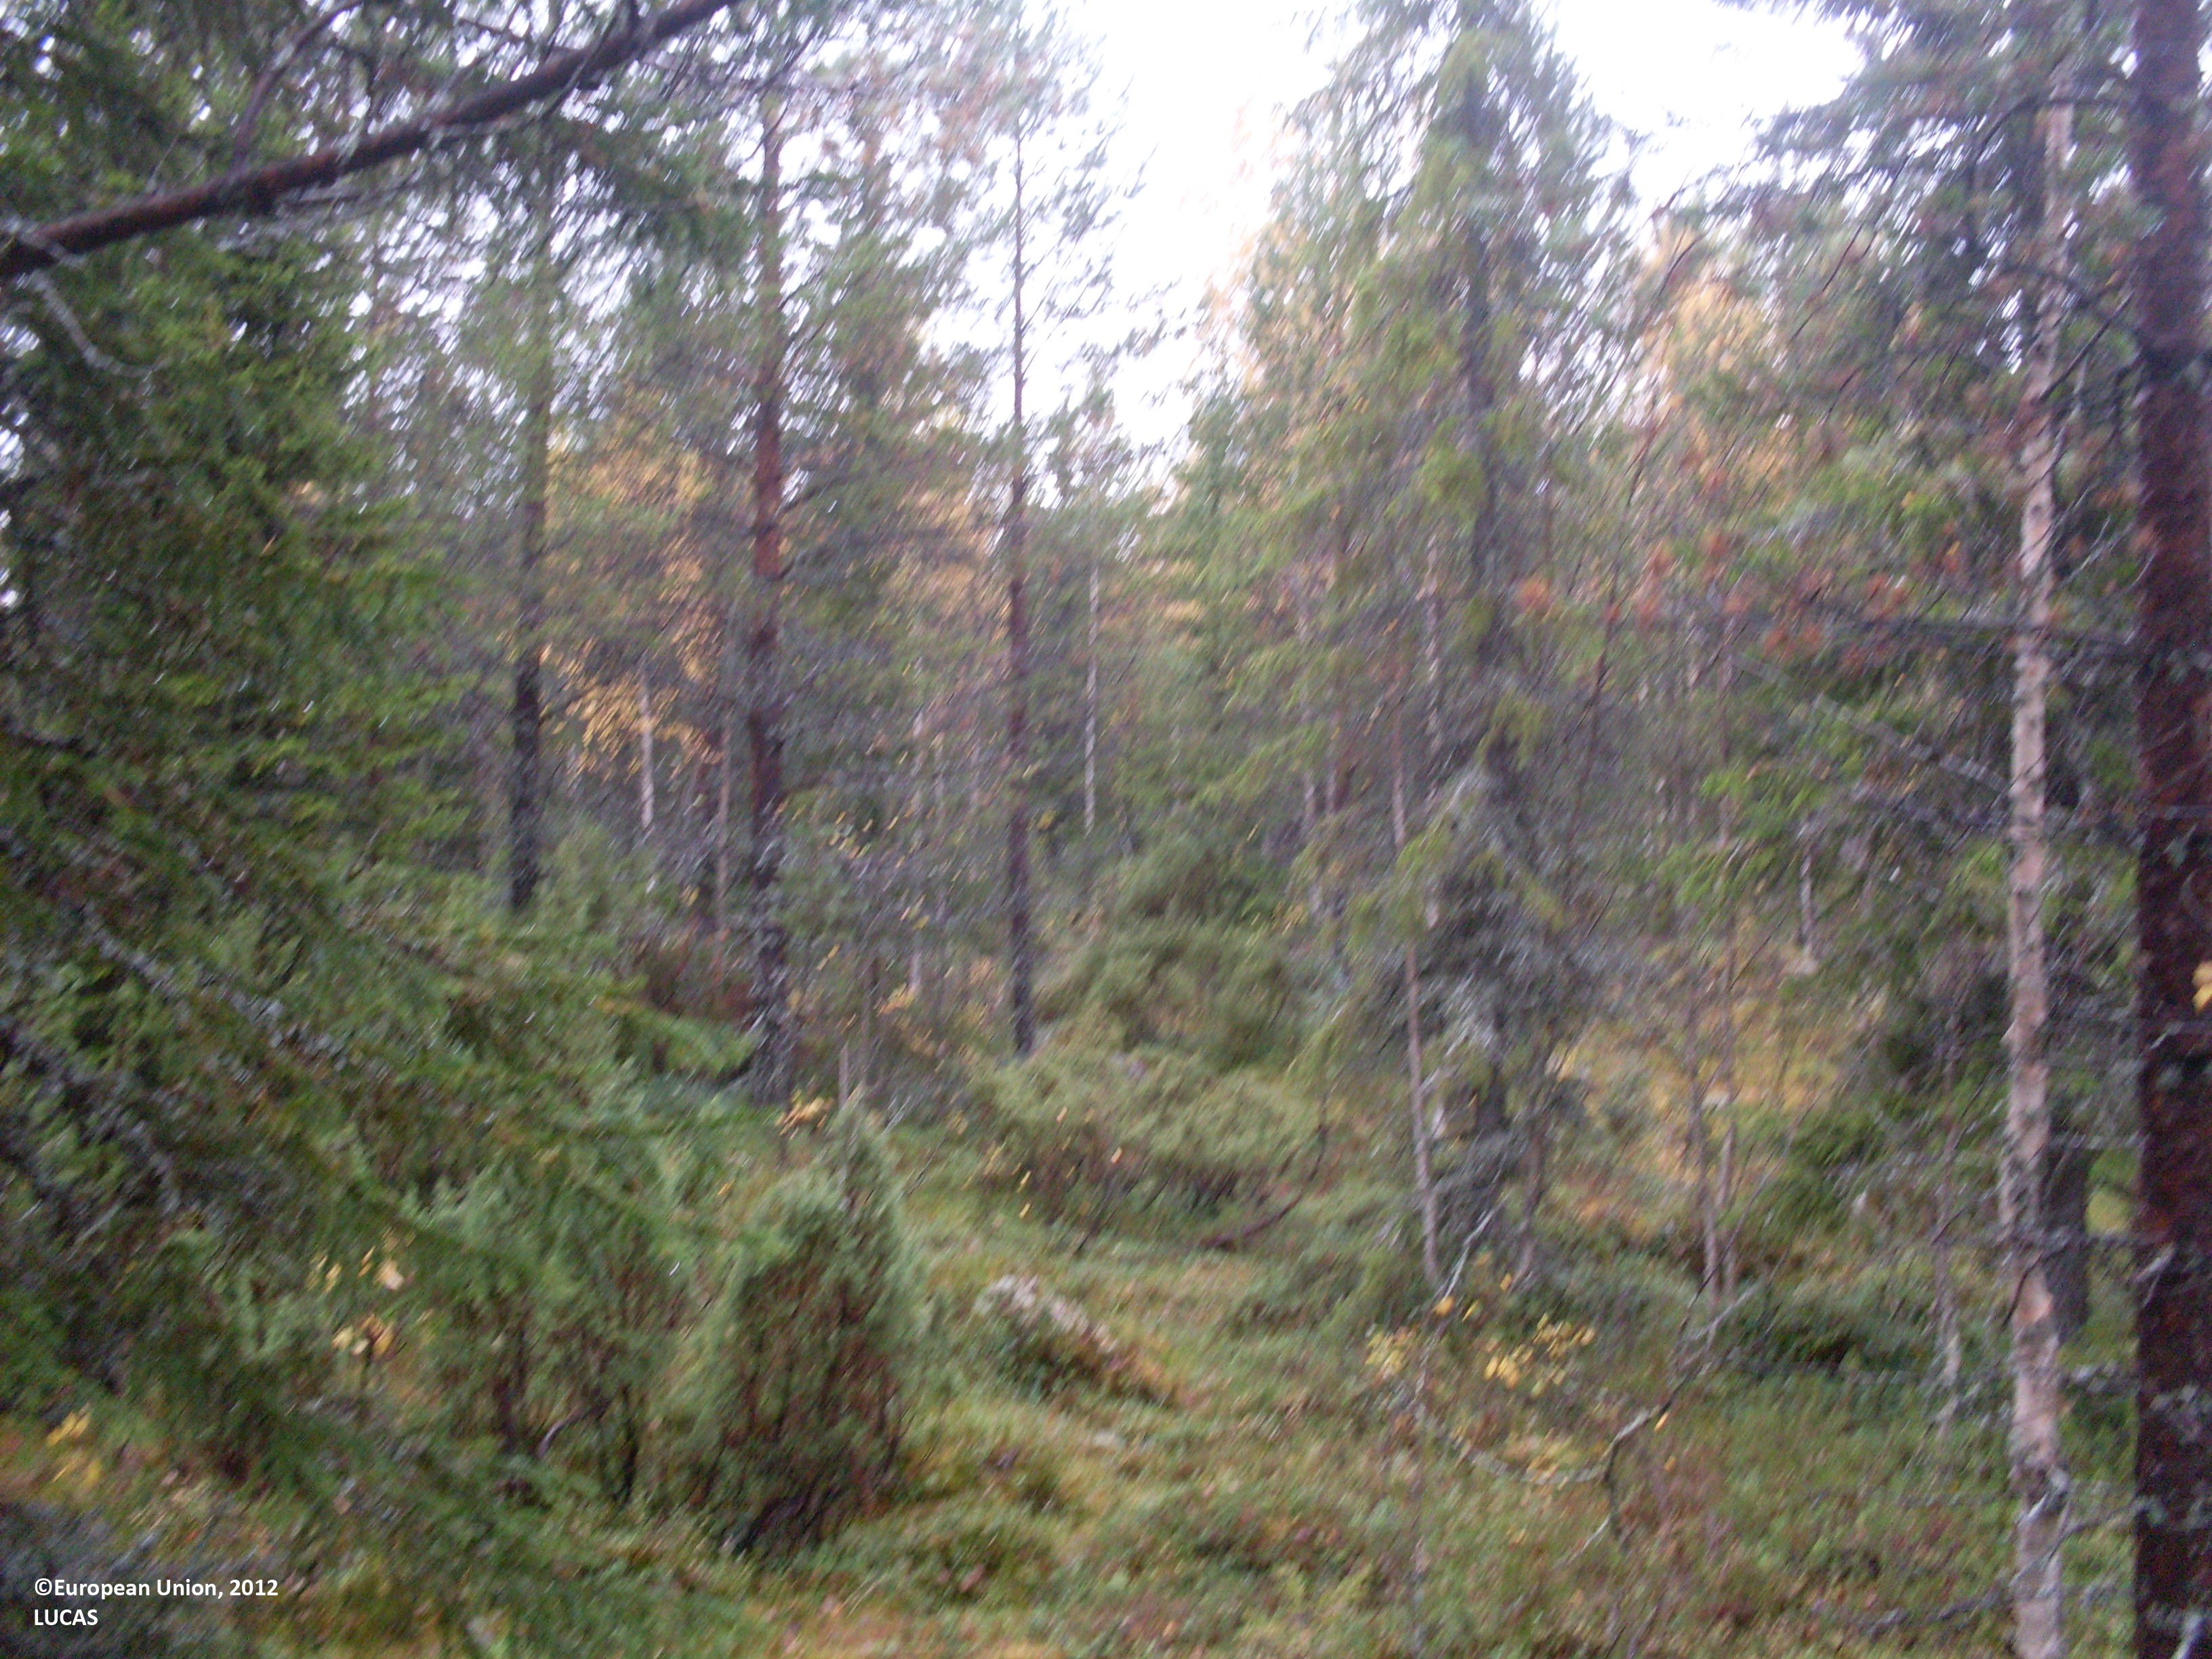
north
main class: Woodland
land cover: Spruce dominated mixed woodland
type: boreal forest
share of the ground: 50 - 75 %
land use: Forestry
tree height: > 5 m
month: September
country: FI
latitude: 64.4348
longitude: 28.6458
